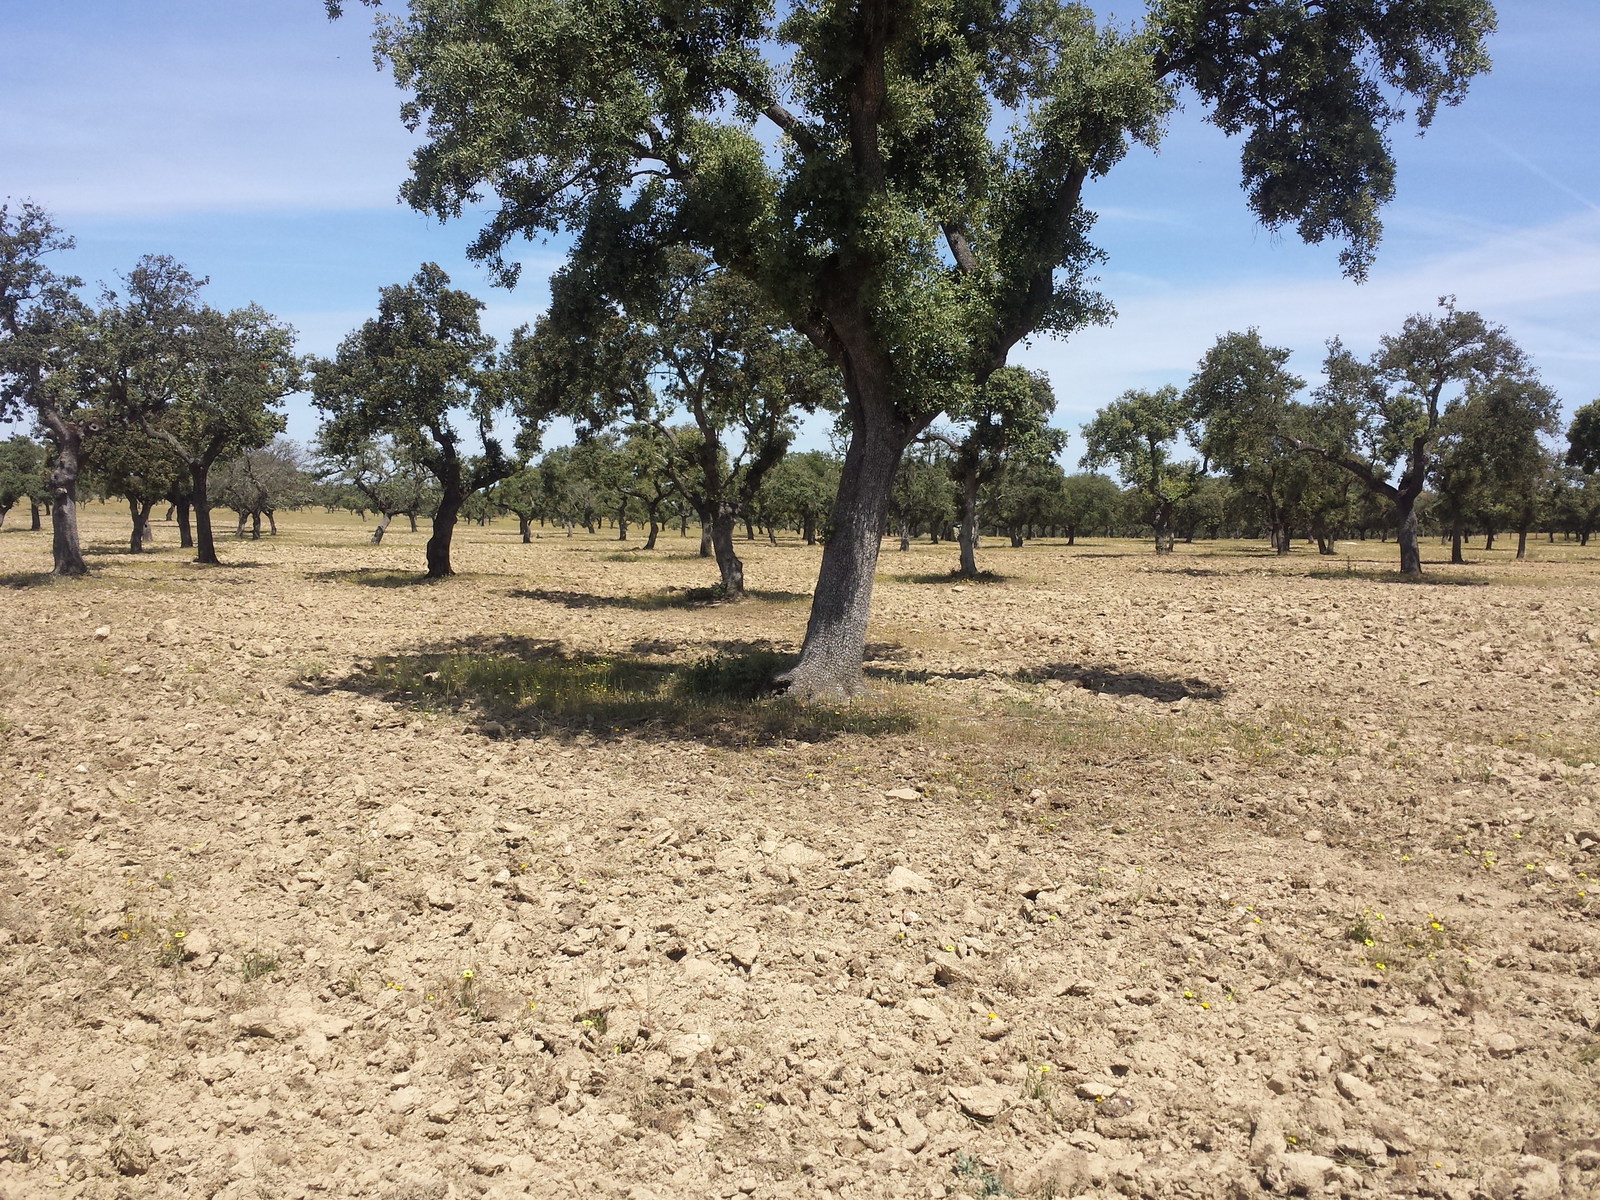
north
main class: Woodland
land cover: Broadleaved woodland
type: broadleaved evergreen forest
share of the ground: 10 - 25 %
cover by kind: unconsolidated bare surface 70 %, broadleaved forest trees 25 %, herbaceous plants 5 %
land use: Forestry
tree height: > 5 m
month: May
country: ES
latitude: 39.5883
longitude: -7.0731
